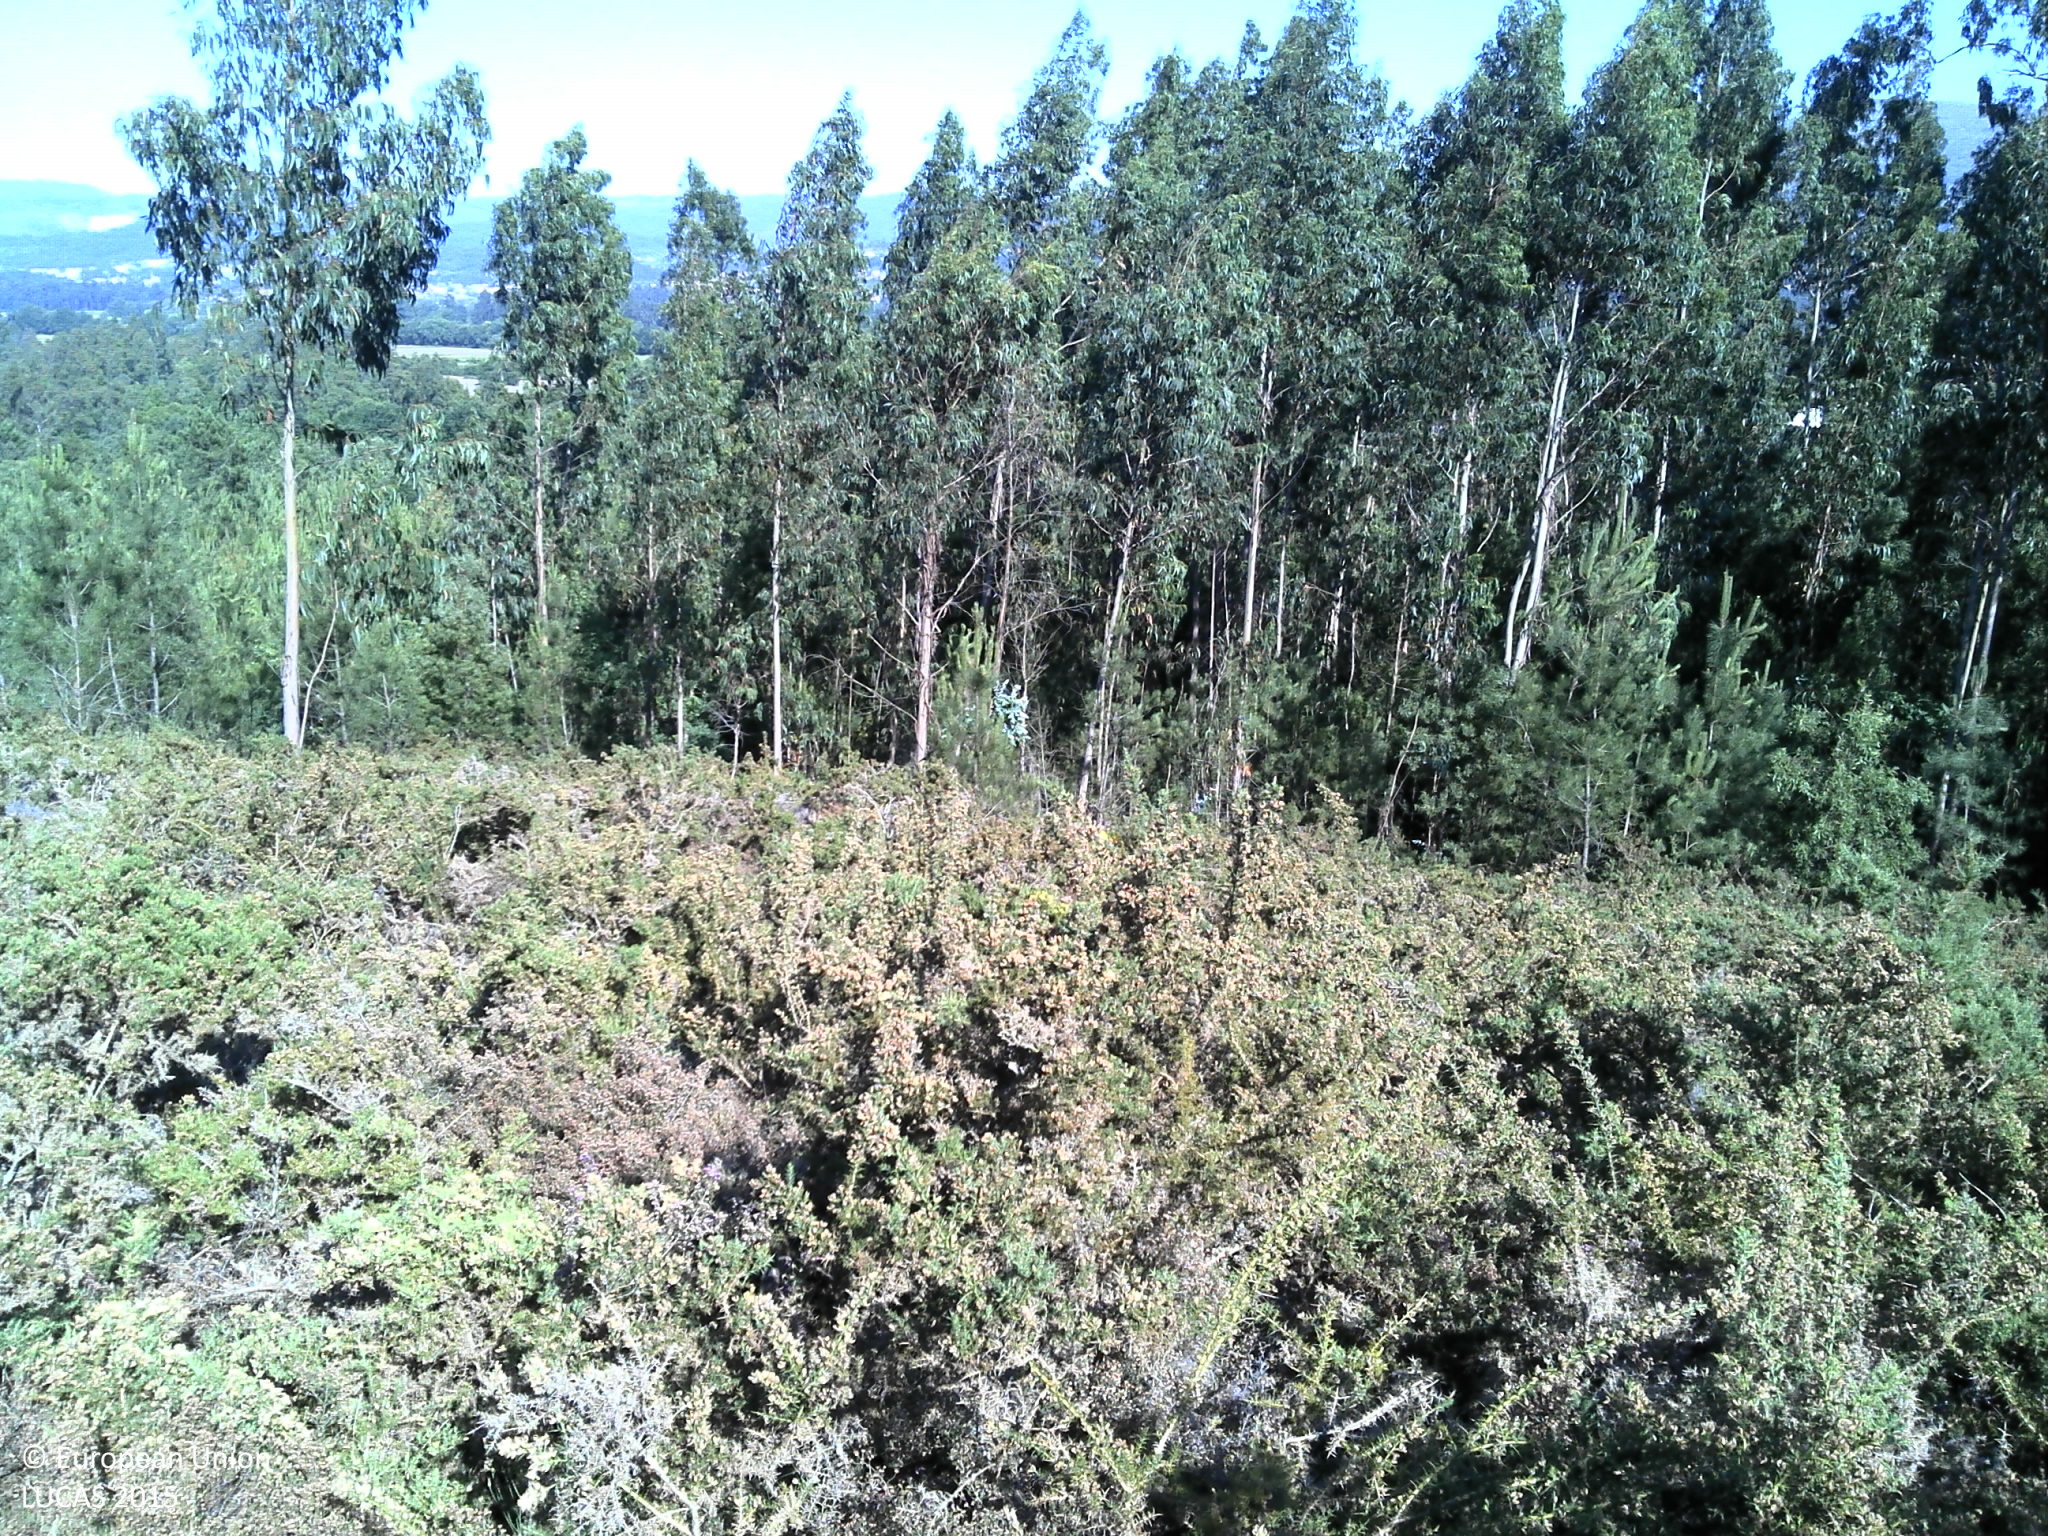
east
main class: Shrubland
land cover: Shrubland without tree cover
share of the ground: > 75 %
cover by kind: shrubs 80 %, herbaceous plants 10 %, unconsolidated bare surface 10 %
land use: Semi-natural and natural areas not in use
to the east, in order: Shrubland without tree cover; Broadleaved woodland; Pine dominated coniferous woodland; Pine dominated mixed woodland; Broadleaved woodland; Fences; Broadleaved woodland; Fences; Shrubland with sparse tree cover; Electric lines; Paved roads, cycling and walking lanes; Fences; Broadleaved woodland
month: May
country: PT
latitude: 41.7542
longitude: -8.6488
